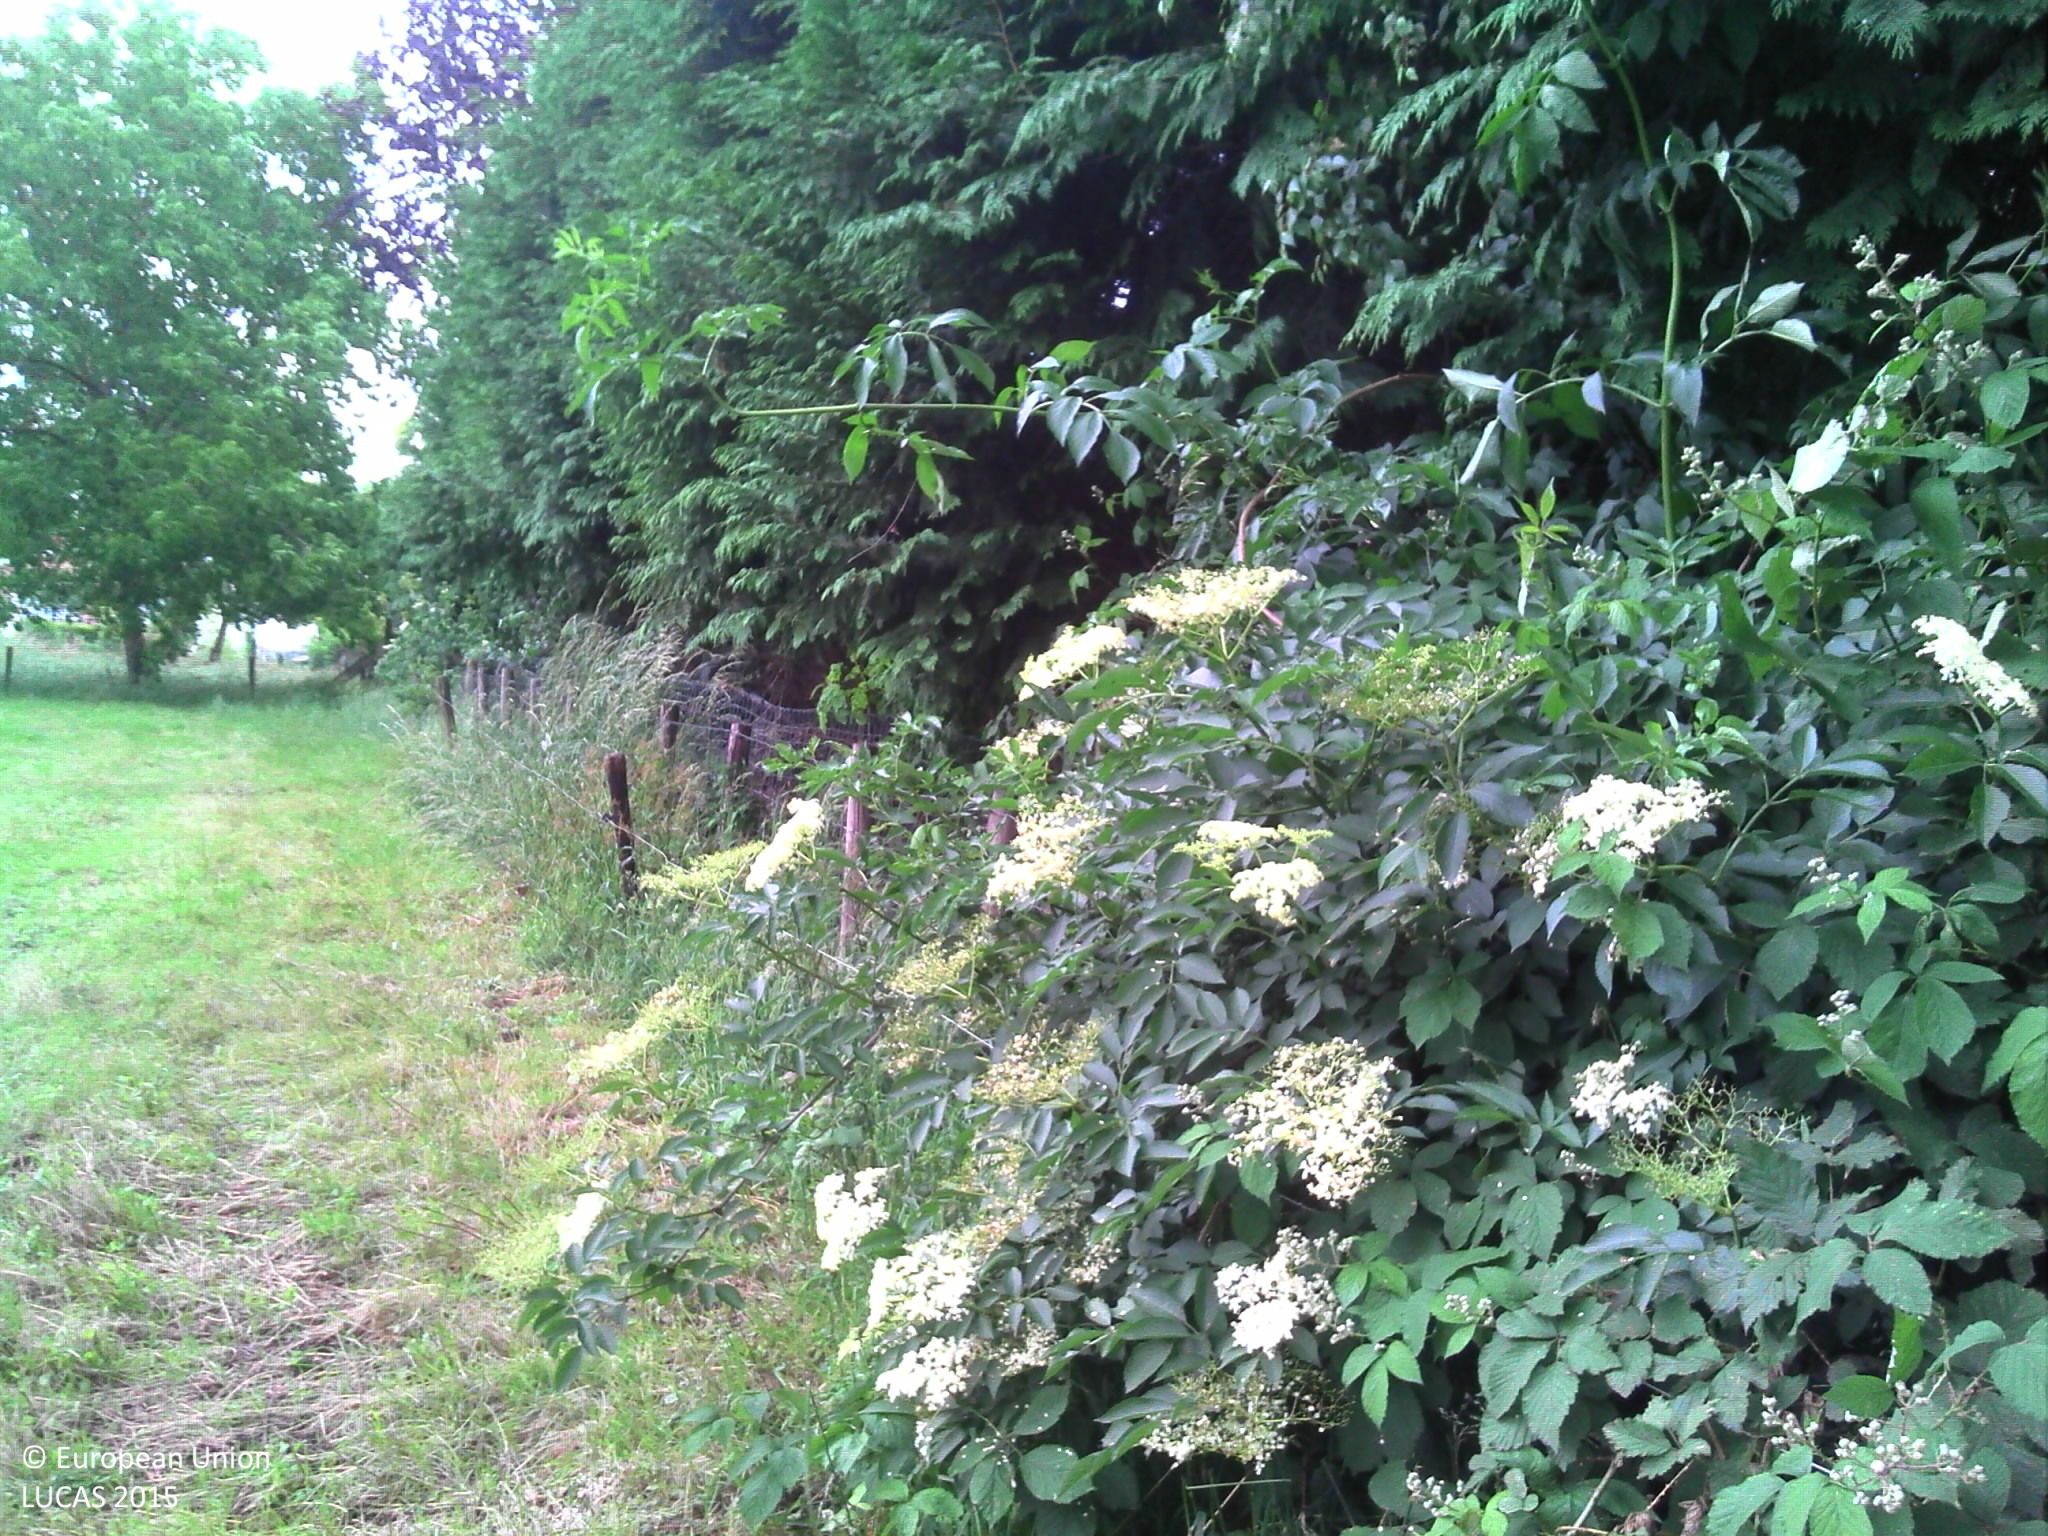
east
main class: Woodland
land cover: Broadleaved woodland
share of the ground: > 75 %
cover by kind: broadleaved forest trees 100 %
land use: Residential
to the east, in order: Broadleaved woodland; Artificial constructions in urban areas; Ditches and canals; Fences; Maize; Artificial constructions in urban areas; Maize; Fences; Ditches and canals; Sugar beet
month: June
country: BE
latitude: 51.1787
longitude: 3.9717
